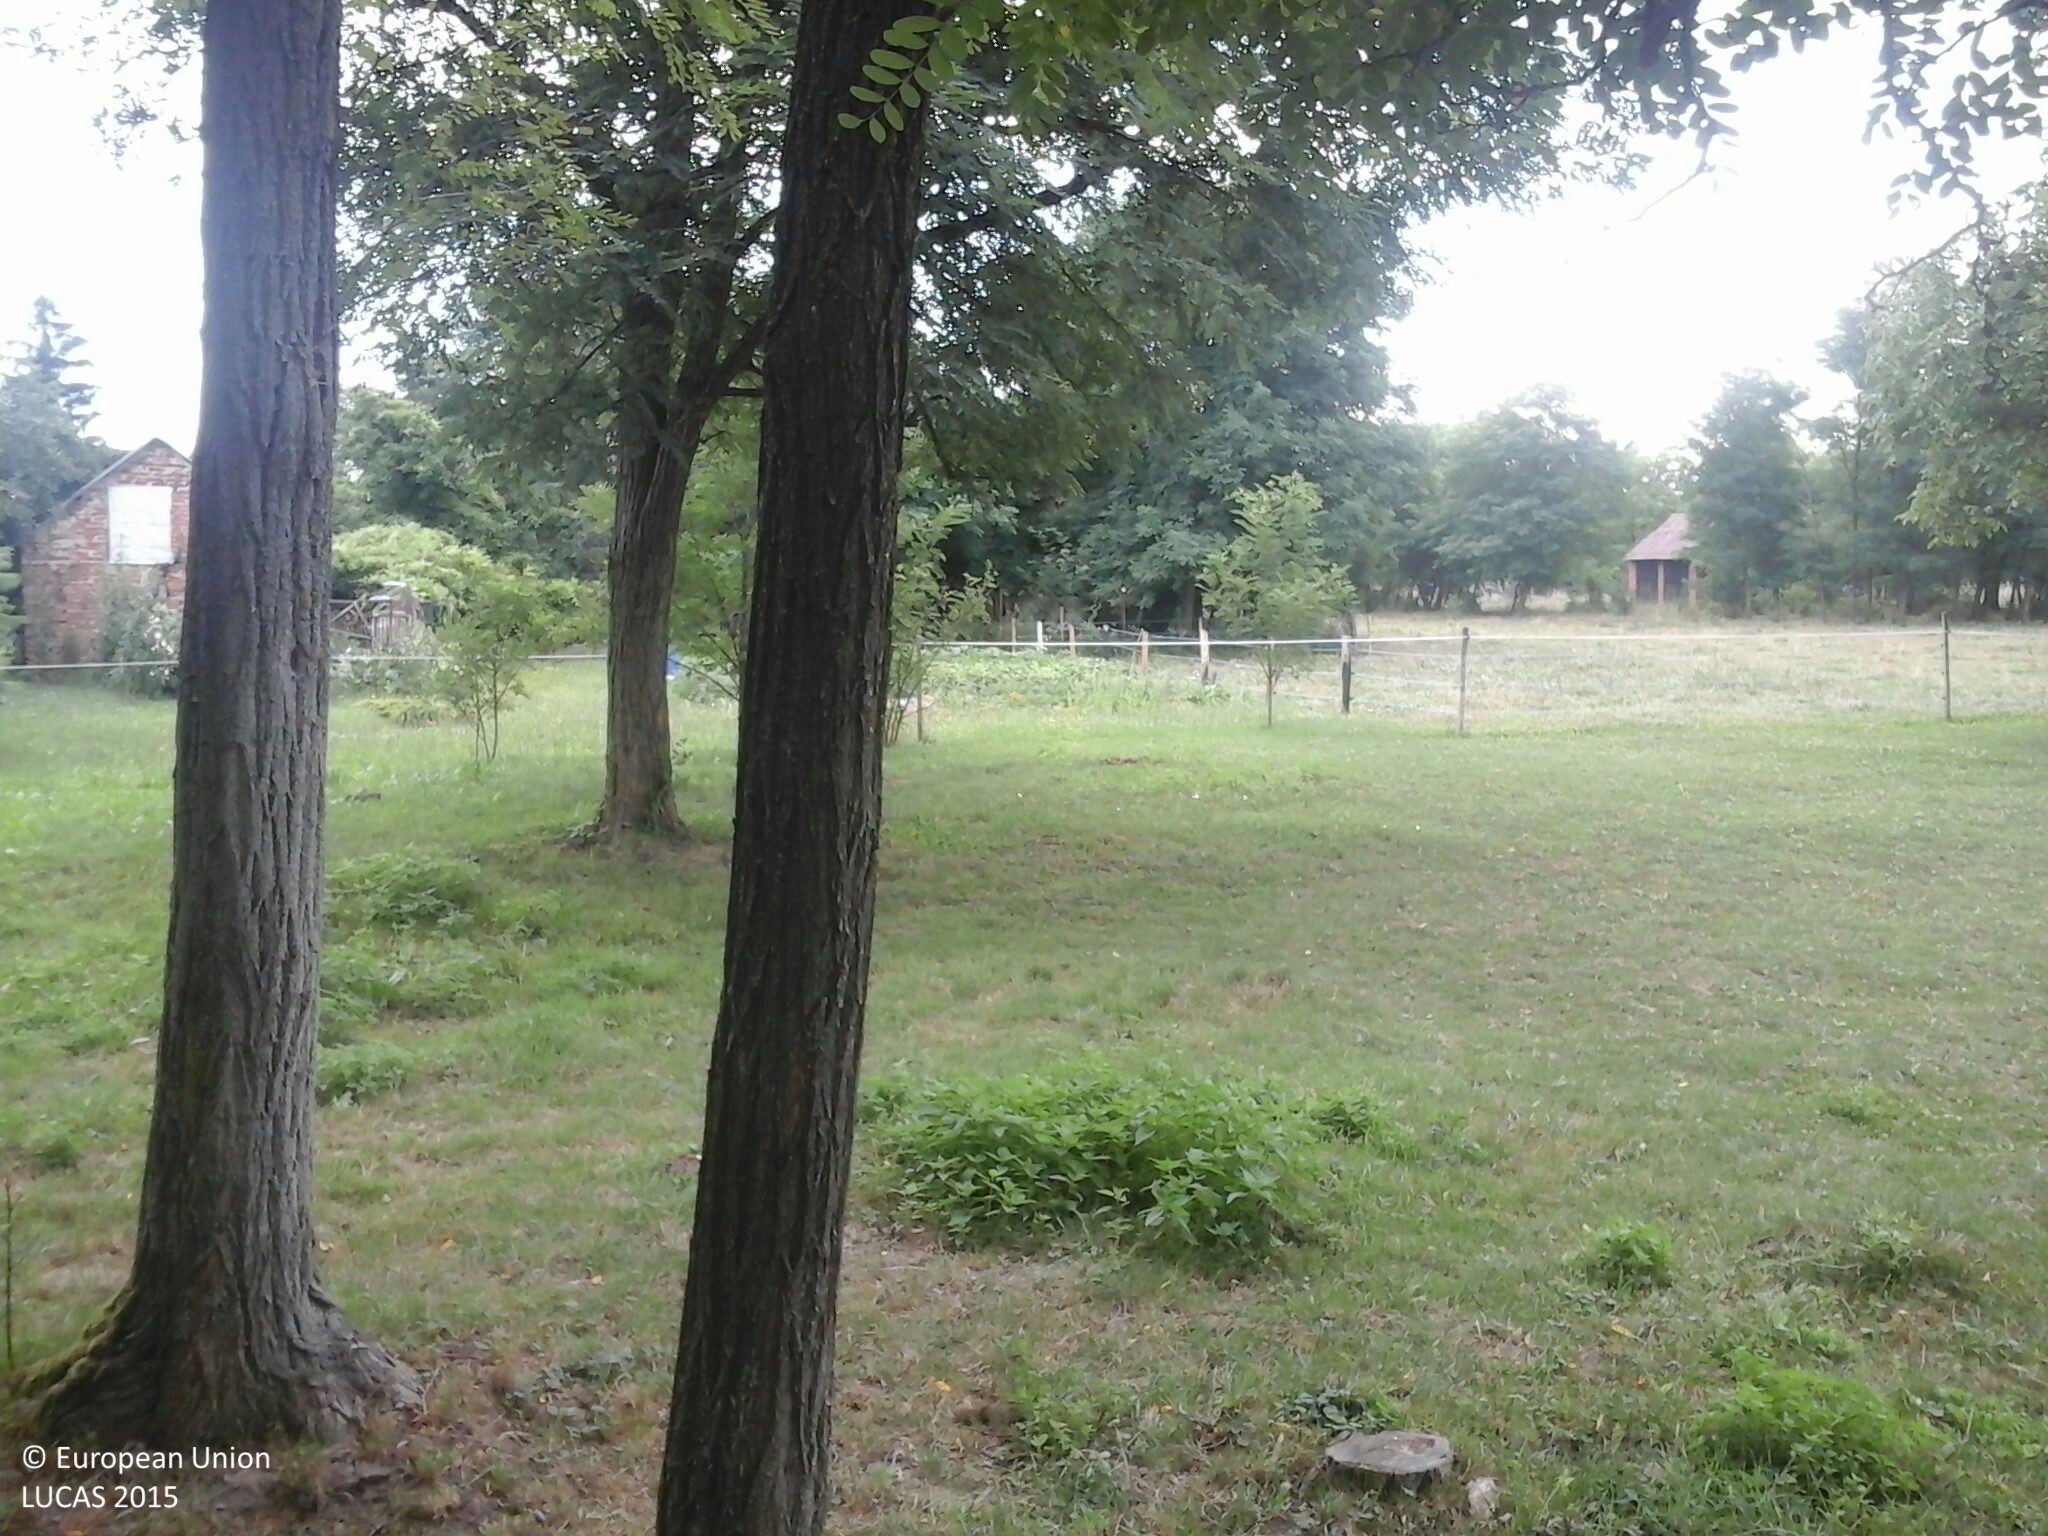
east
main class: Woodland
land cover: Broadleaved woodland
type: exotic forest
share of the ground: 50 - 75 %
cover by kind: herbaceous plants 60 %, broadleaved forest trees 40 %
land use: Residential
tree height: > 5 m
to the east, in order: Broadleaved woodland; Grassland without tree/shrub cover; Artificial constructions in urban areas; Grassland with sparse tree/shrub cover
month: July
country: HU
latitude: 47.0702
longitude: 16.5740
